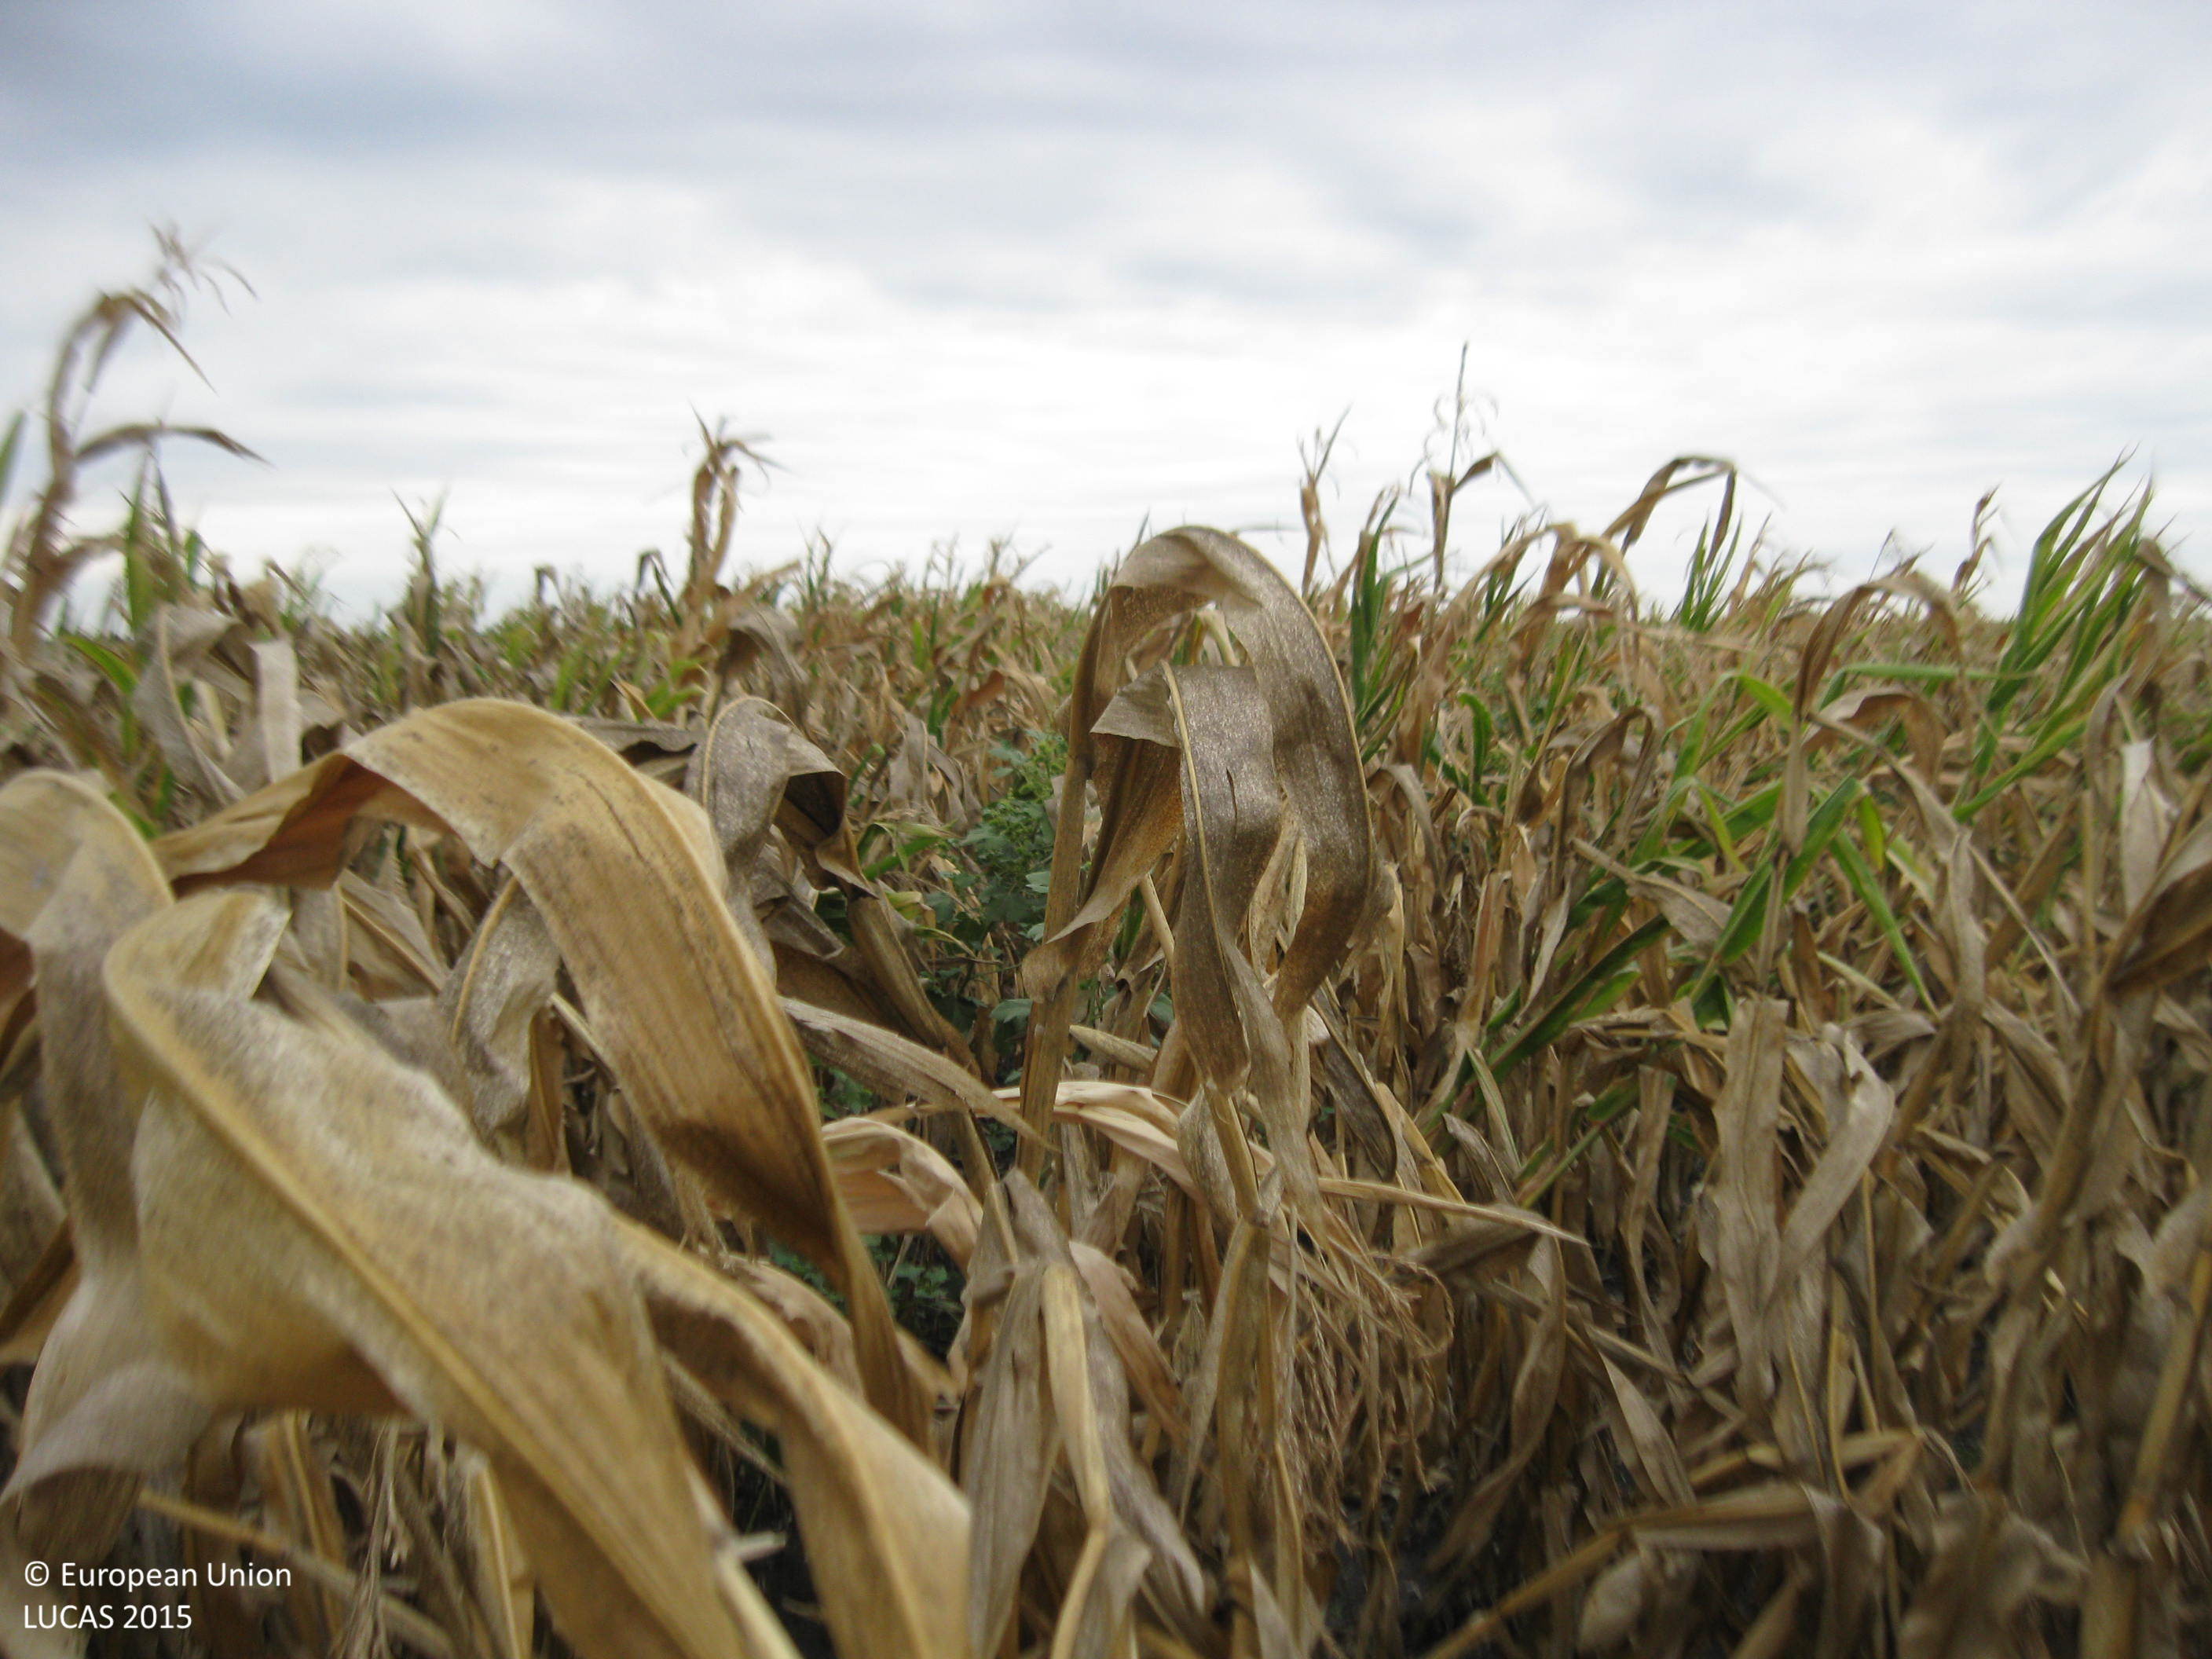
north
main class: Cropland
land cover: Maize
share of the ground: > 75 %
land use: Agriculture (excluding fallow land and kitchen gardens)
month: September
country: BG
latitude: 42.0679
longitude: 25.0791
